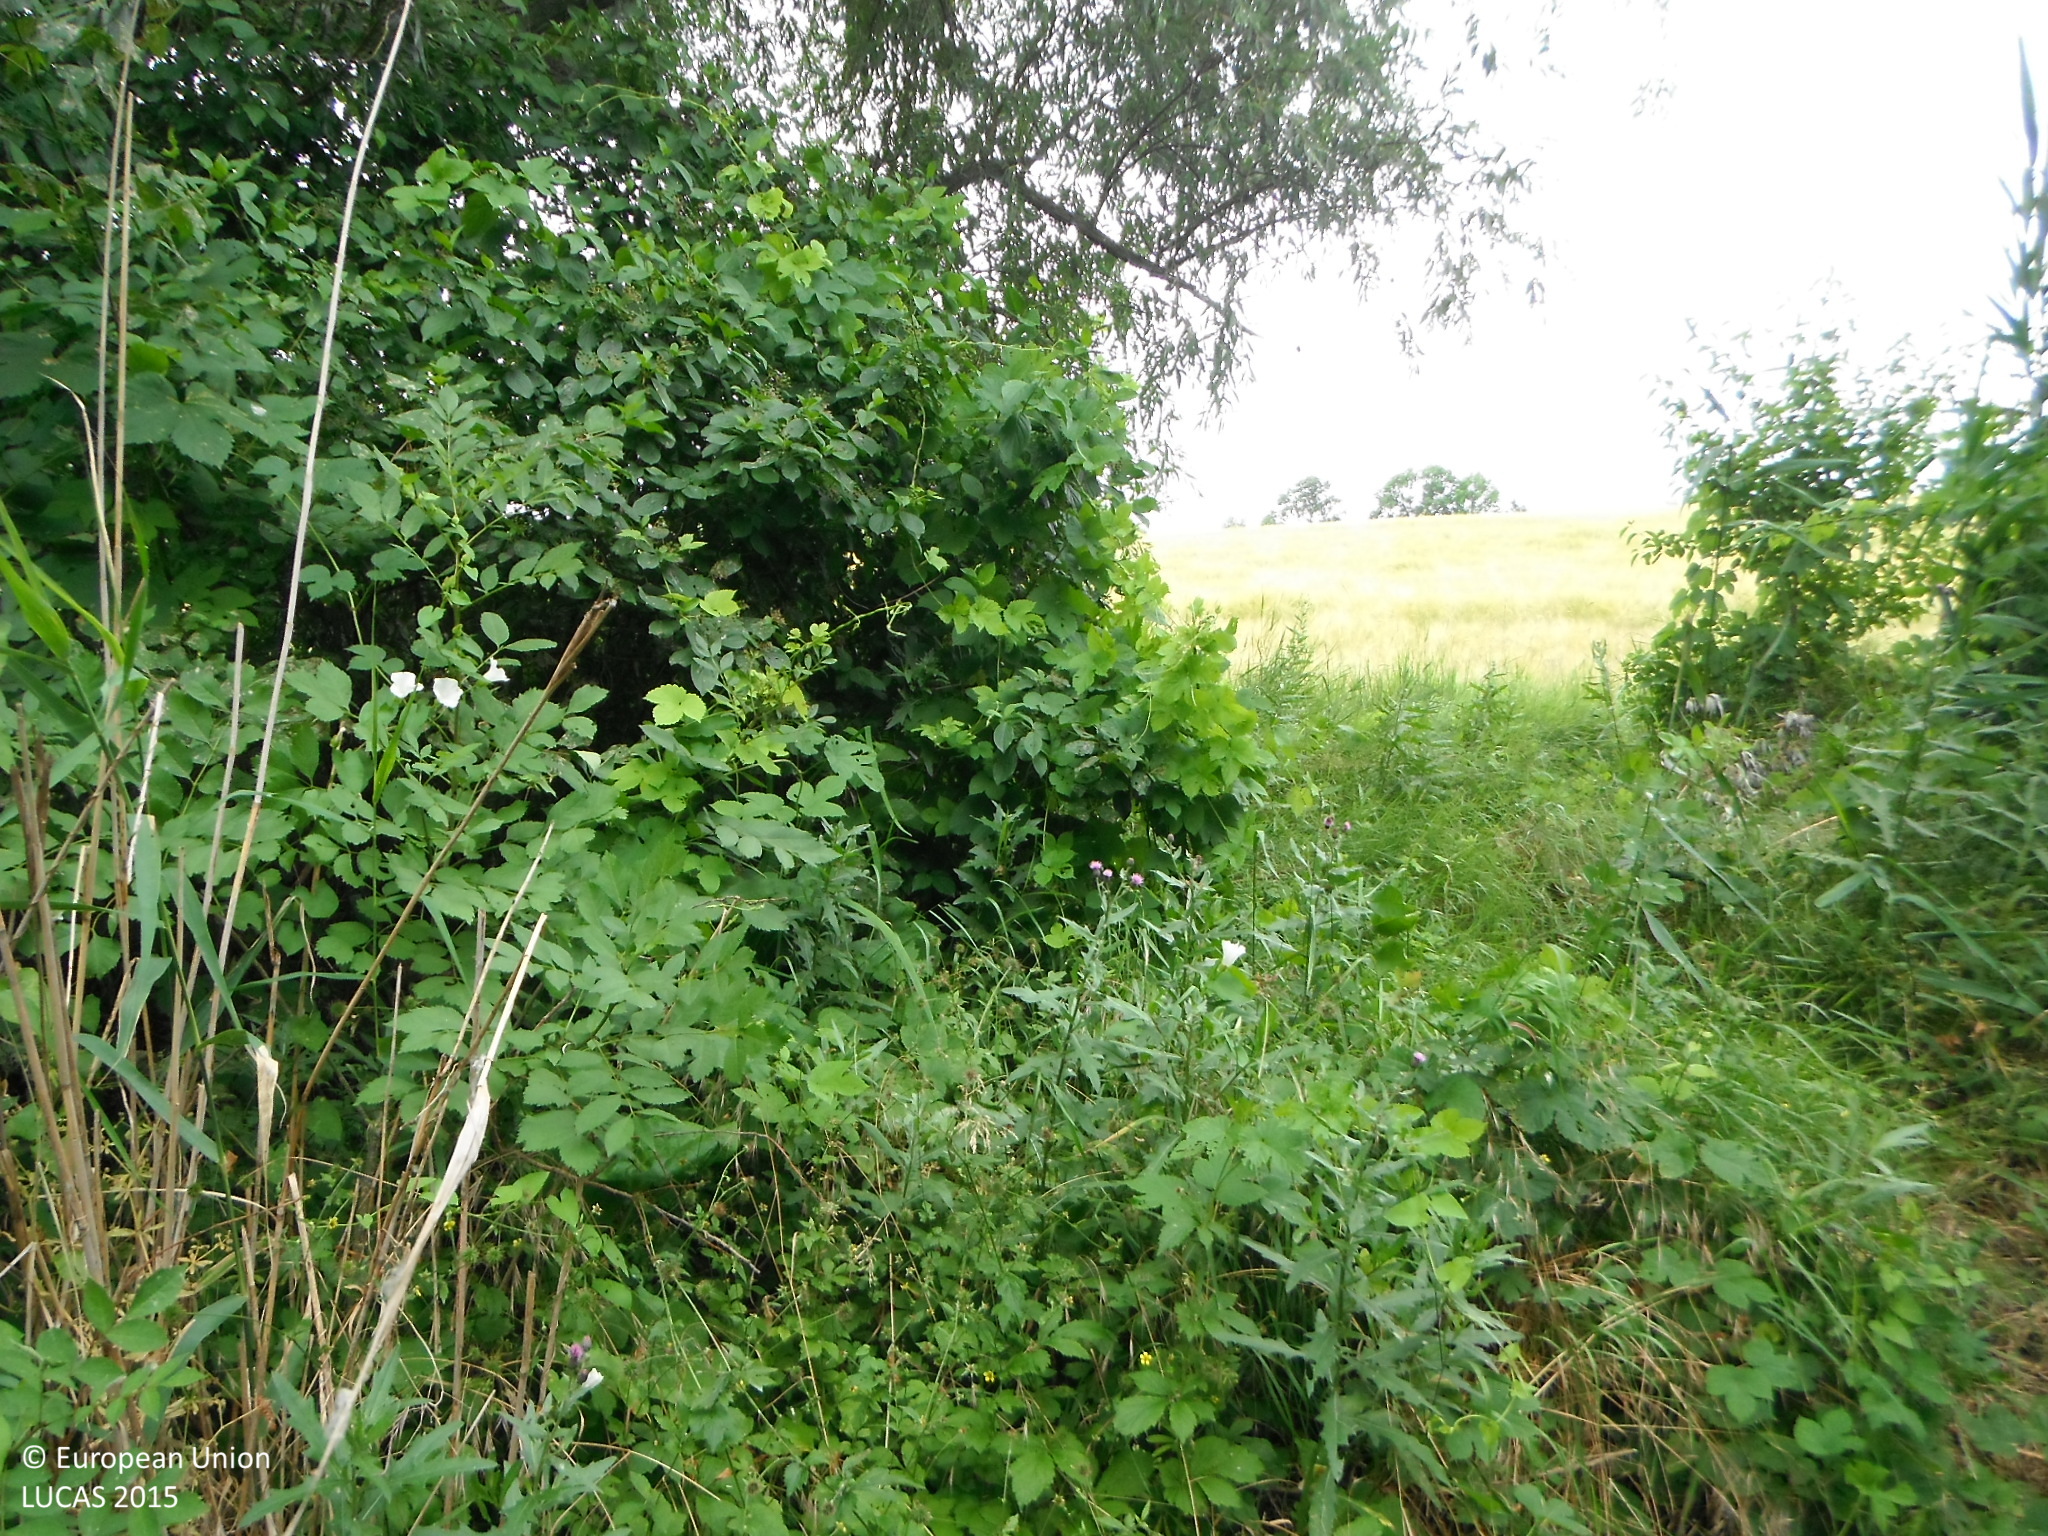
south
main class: Woodland
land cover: Broadleaved woodland
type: mire and swamp forests
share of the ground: > 75 %
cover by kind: broadleaved forest trees 95 %, herbaceous plants 5 %
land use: Semi-natural and natural areas not in use
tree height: > 5 m
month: June
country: SK
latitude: 48.1627
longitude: 18.0666
